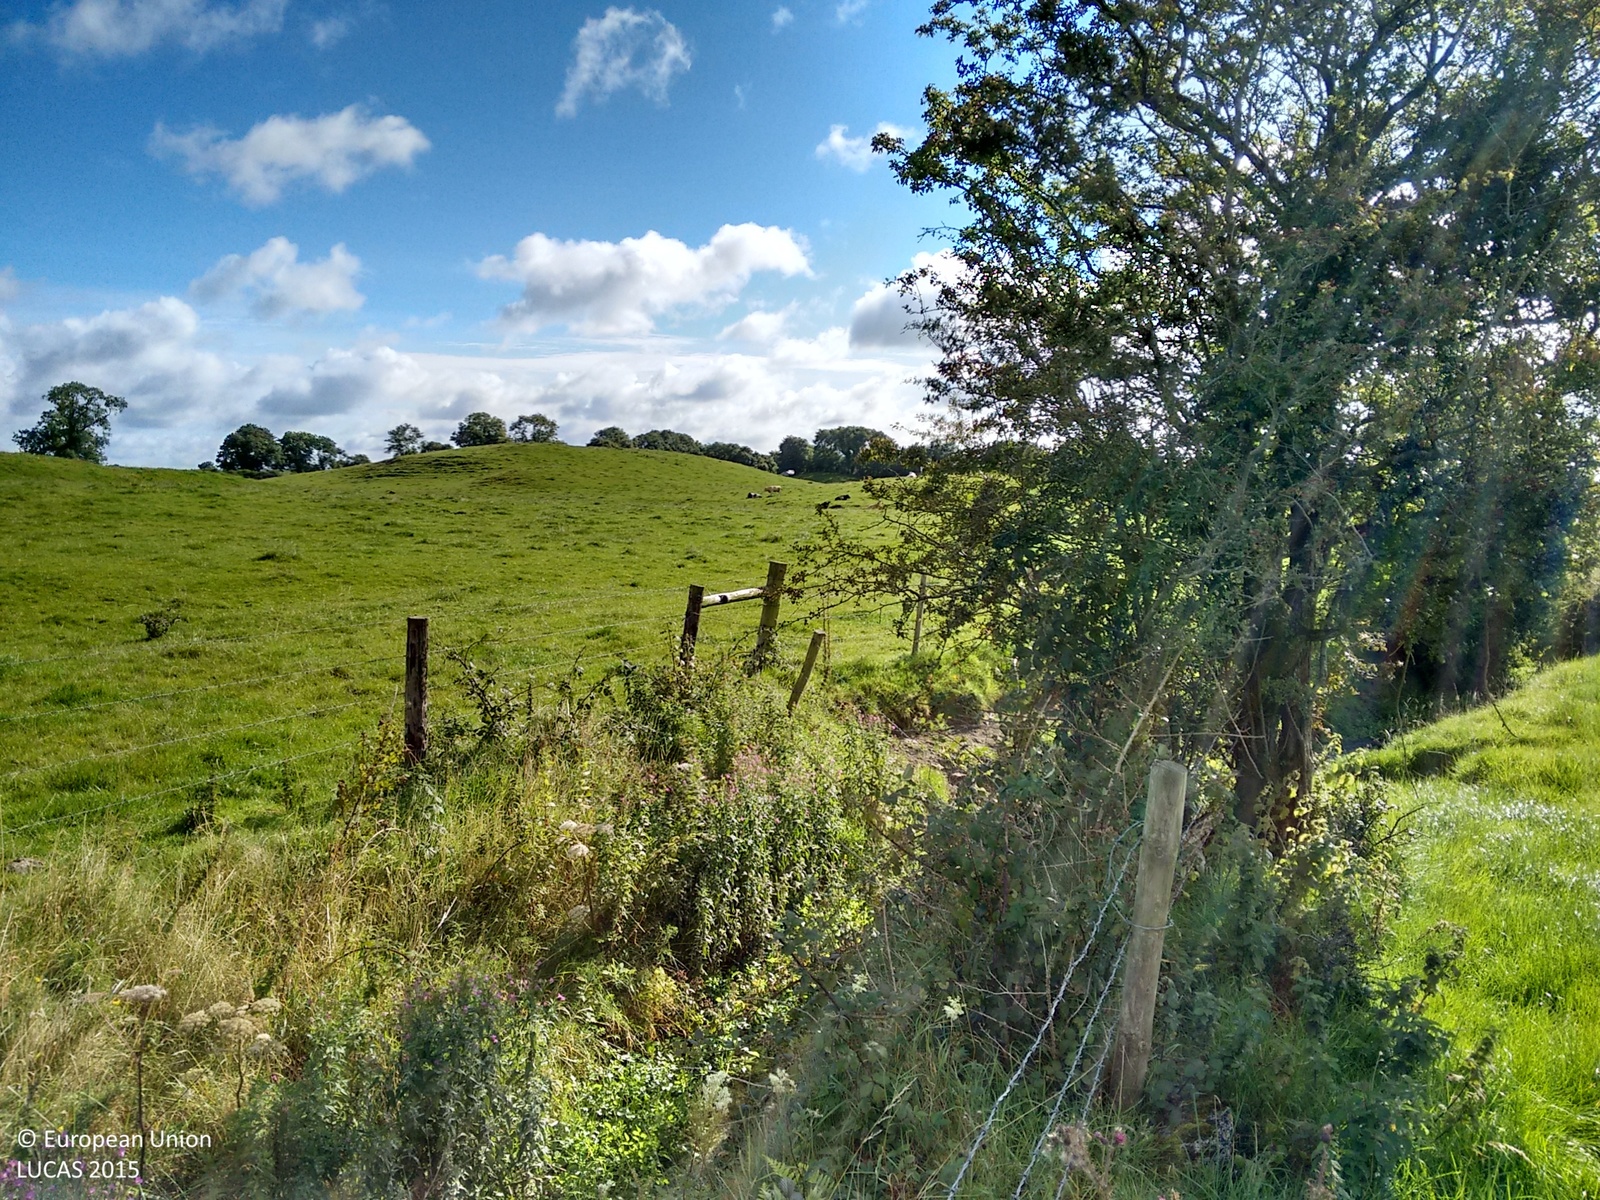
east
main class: Grassland
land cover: Grassland without tree/shrub cover
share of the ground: > 75 %
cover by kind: herbaceous plants 100 %
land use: Agriculture (excluding fallow land and kitchen gardens)
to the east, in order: Grassland without tree/shrub cover
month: September
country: IE
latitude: 53.7010
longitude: -7.0942
